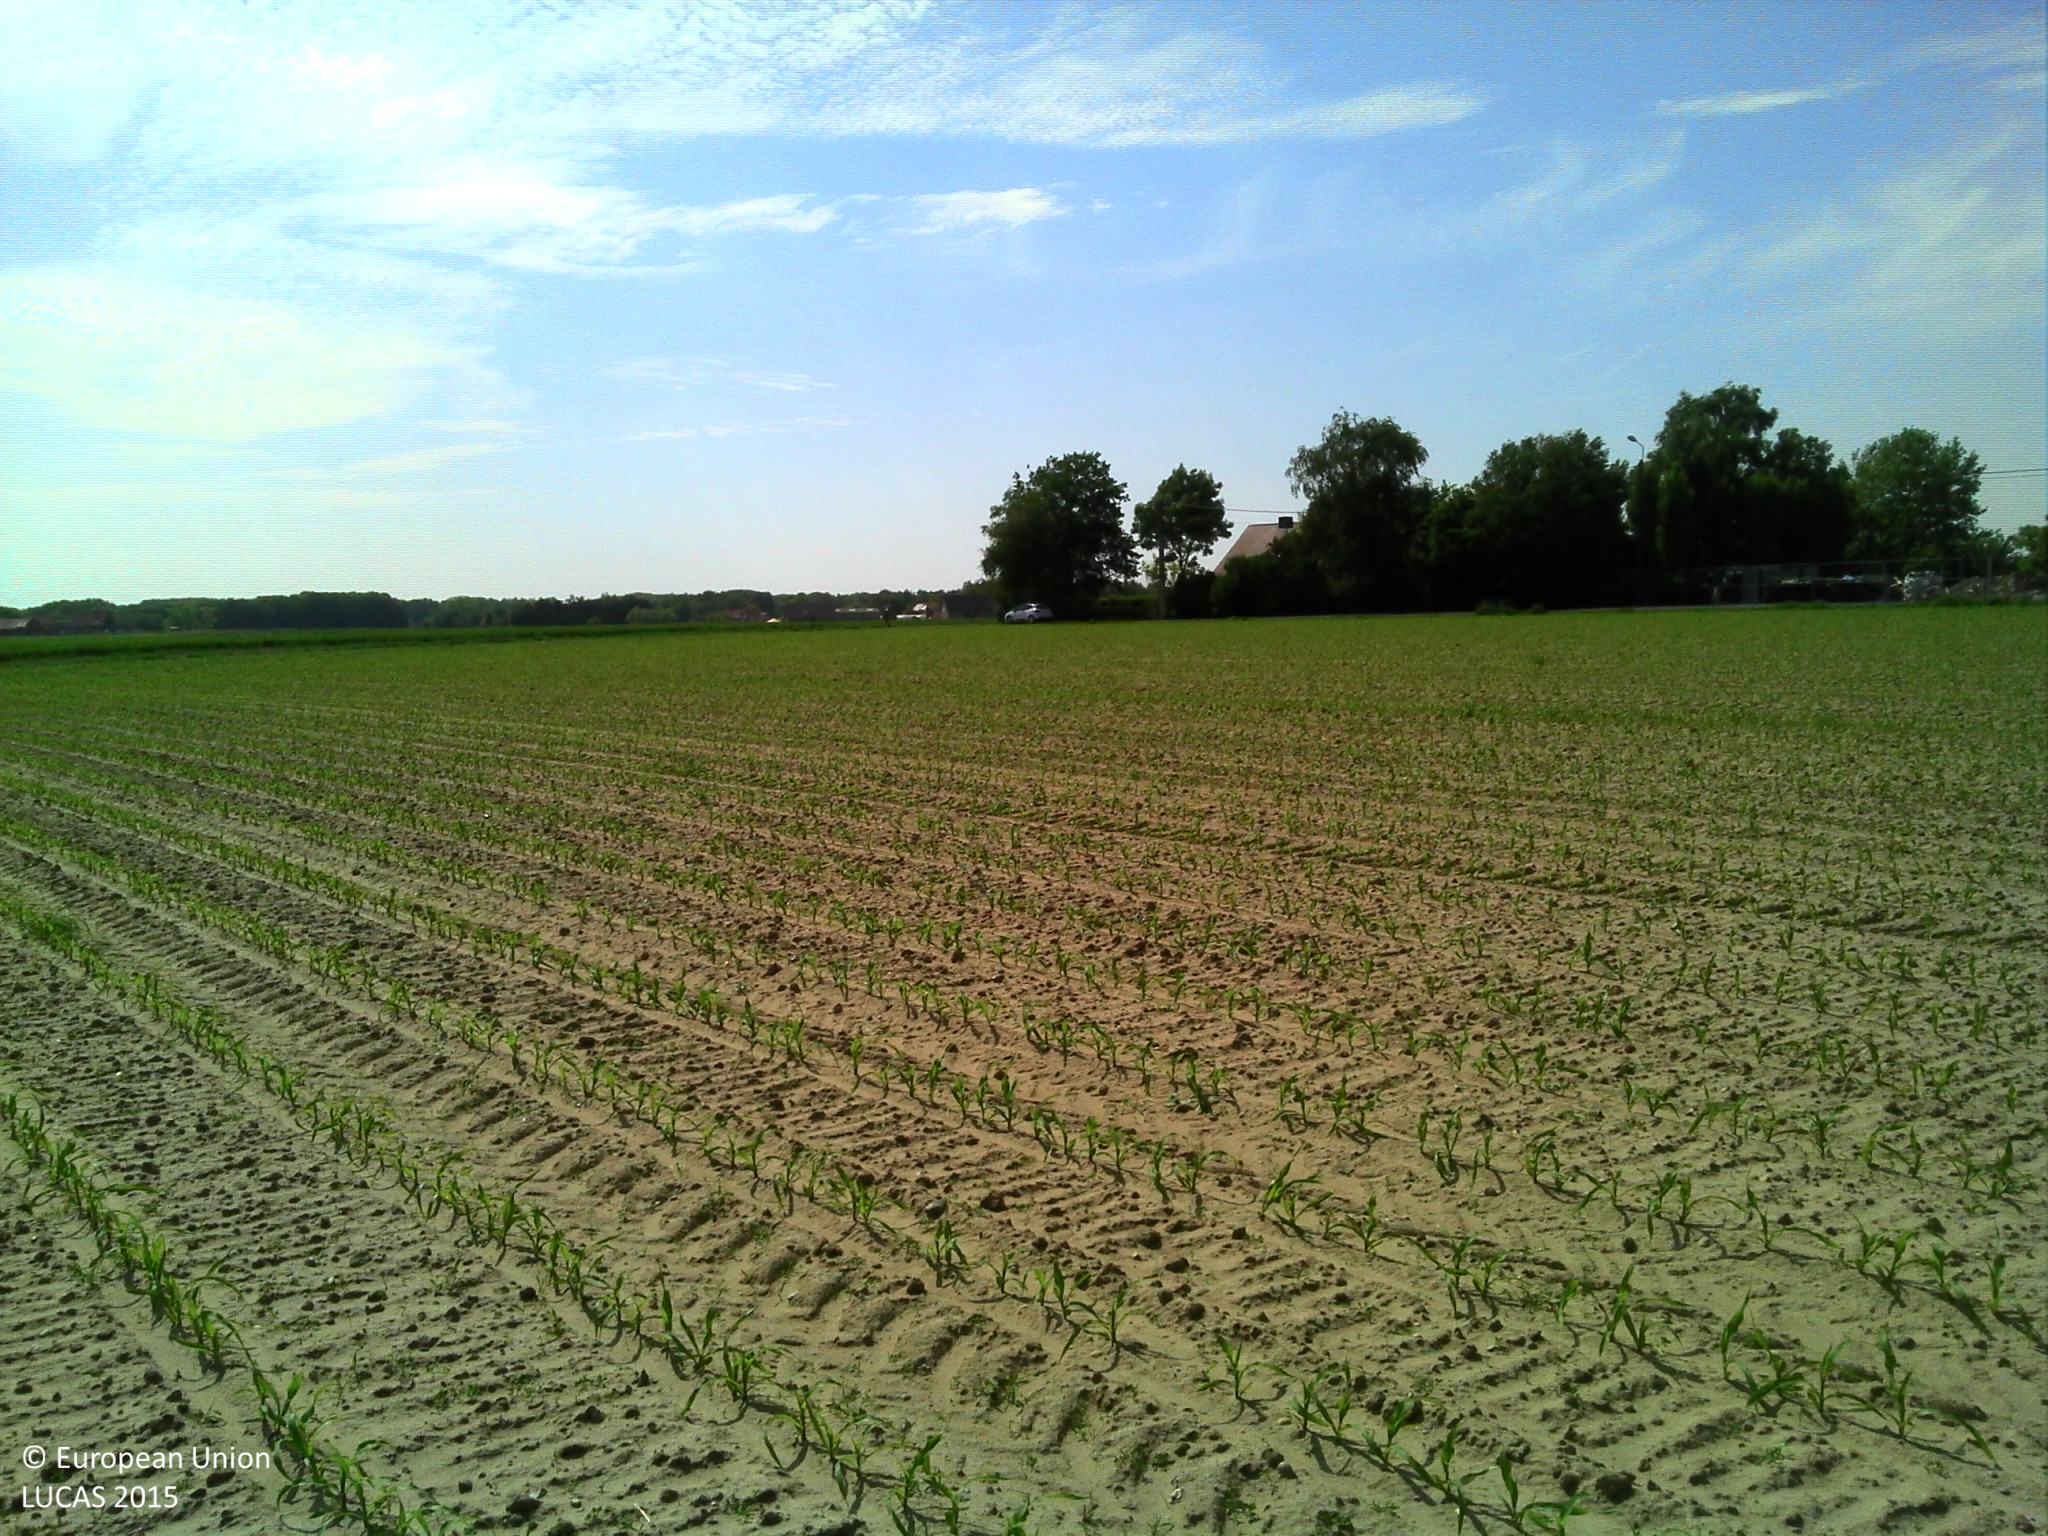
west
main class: Cropland
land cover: Maize
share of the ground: < 10 %
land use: Agriculture (excluding fallow land and kitchen gardens)
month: June
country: BE
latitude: 50.8543
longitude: 3.0152
